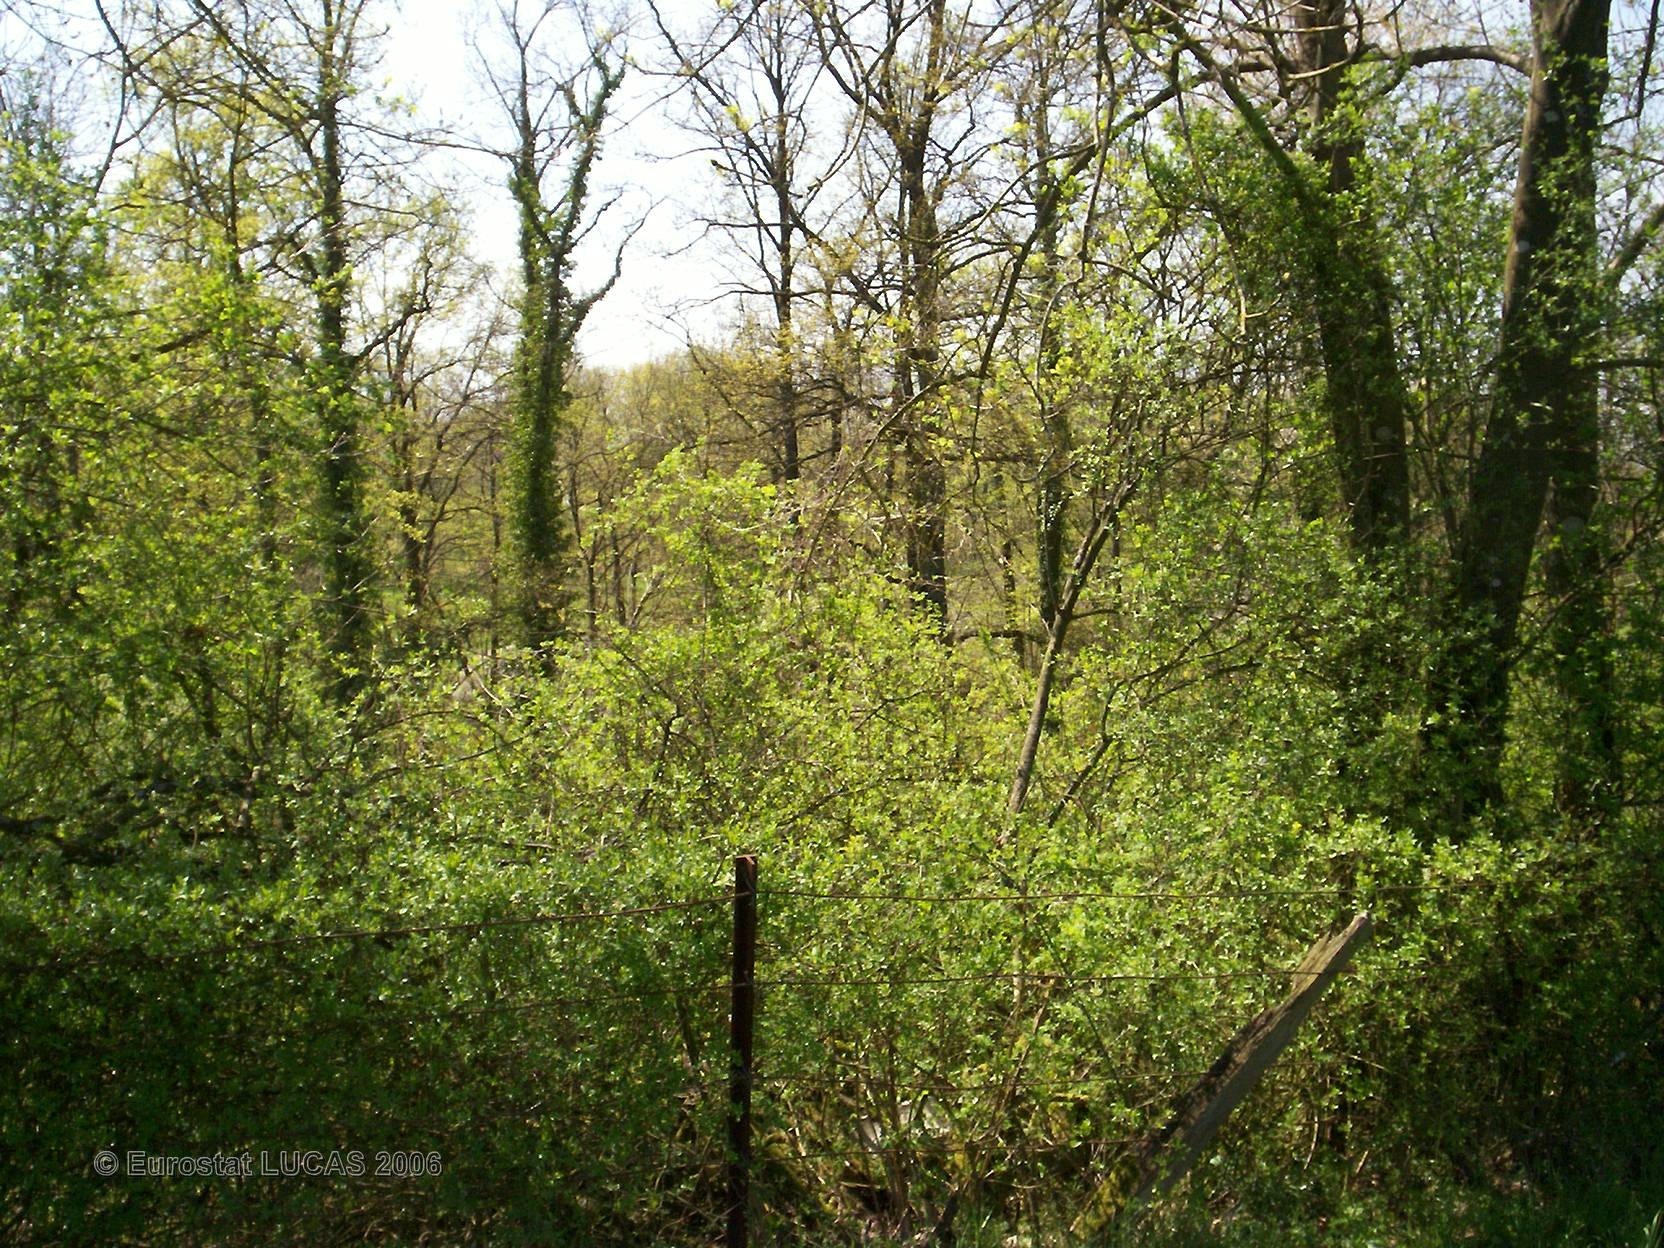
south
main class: Grassland
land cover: Grassland without tree/shrub cover
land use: Agriculture (excluding fallow land and kitchen gardens)
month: April
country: FR
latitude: 49.6673
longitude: 4.3844
